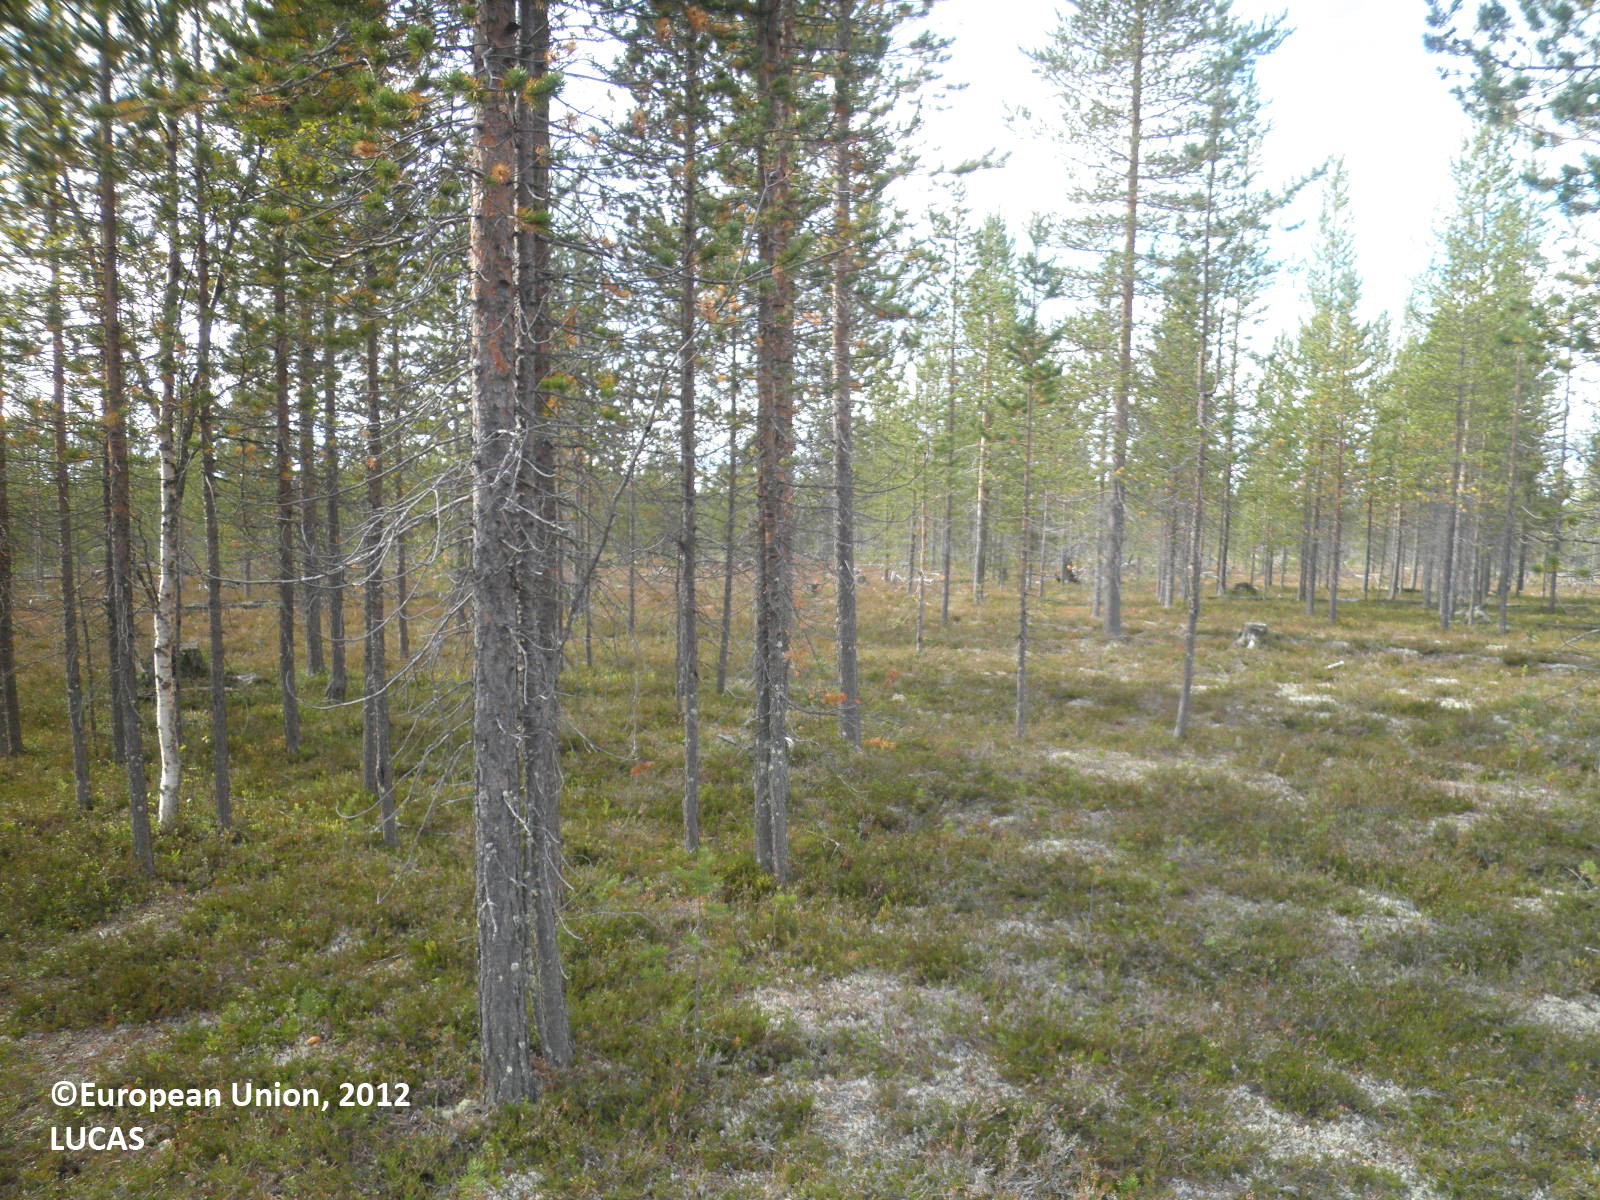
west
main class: Woodland
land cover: Pine dominated coniferous woodland
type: boreal forest
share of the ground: 25 - 50 %
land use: Forestry
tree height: > 5 m
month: August
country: FI
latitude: 67.9876
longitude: 28.2086
